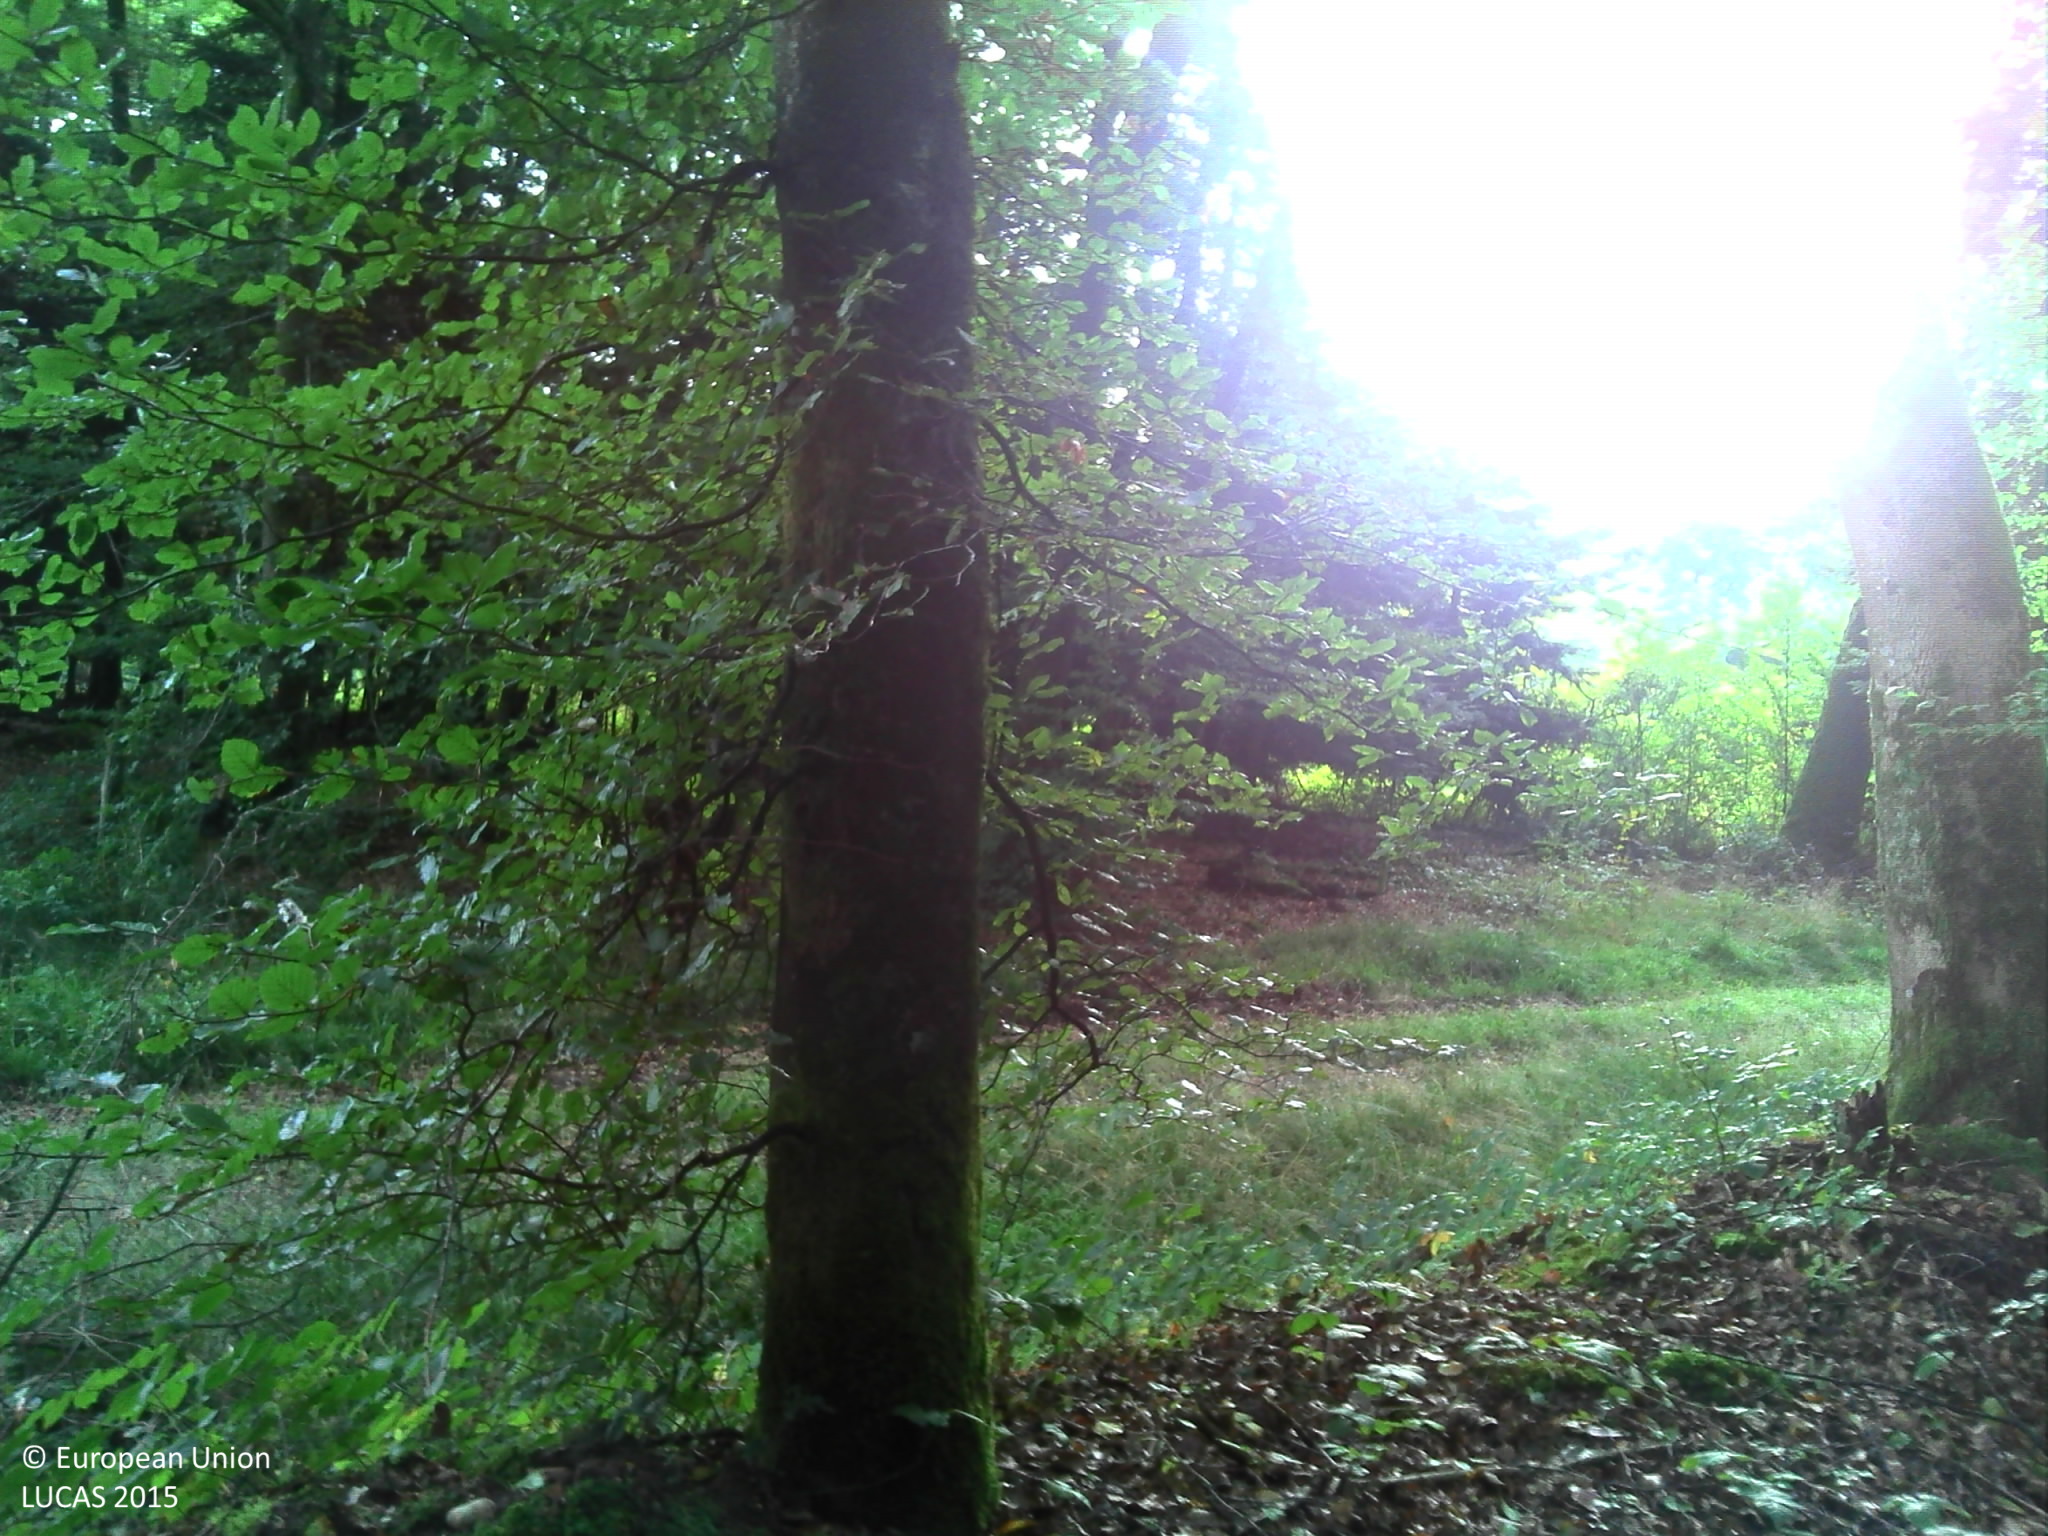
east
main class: Woodland
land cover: Other mixed woodland
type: hemiboreal forest and nemoral coniferous forest and mixed broadleaved-coniferous forest
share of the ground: > 75 %
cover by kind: broadleaved forest trees 45 %, coniferous forest trees 40 %, consolidated bare surface 10 %, herbaceous plants 5 %
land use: Forestry
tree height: > 5 m
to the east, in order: Other mixed woodland; Grass margins; Tracks; Spruce dominated mixed woodland; Shruby margins; Grassland without tree/shrub cover; Shruby margins; Fences; Broadleaved woodland; Grassland without tree/shrub cover; Broadleaved woodland; Shruby margins; Grassland without tree/shrub cover
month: September
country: FR
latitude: 48.4659
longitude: 6.8224
